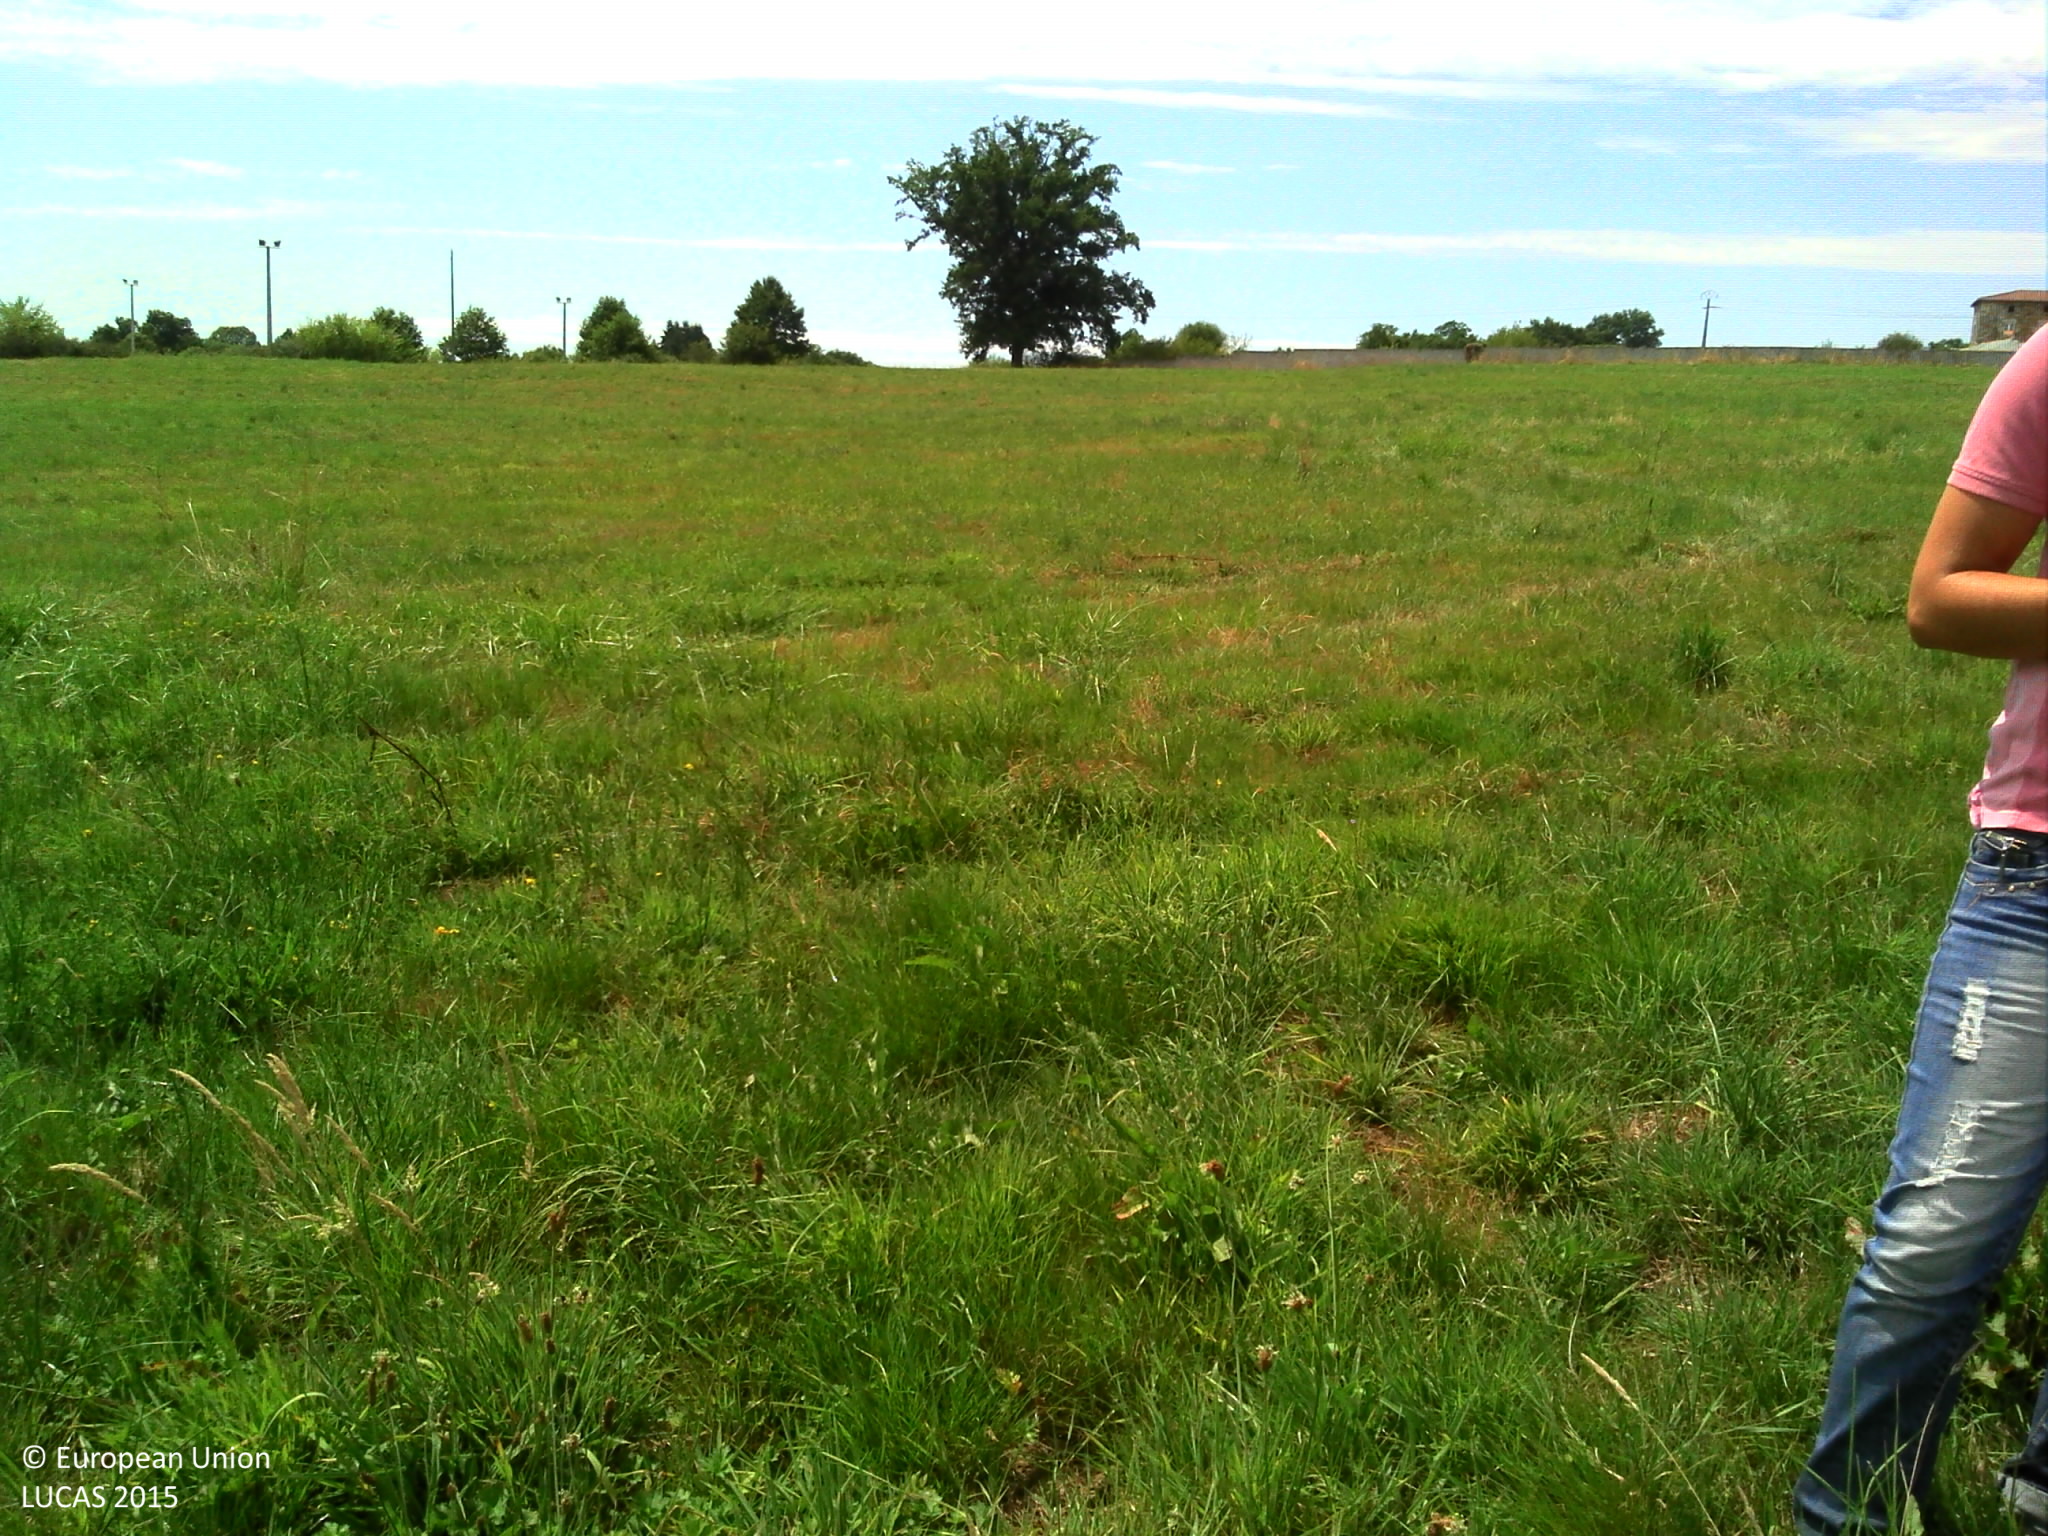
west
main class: Grassland
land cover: Grassland without tree/shrub cover
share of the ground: > 75 %
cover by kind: herbaceous plants 100 %
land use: Agriculture (excluding fallow land and kitchen gardens)
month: July
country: FR
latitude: 45.8813
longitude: 1.0082
